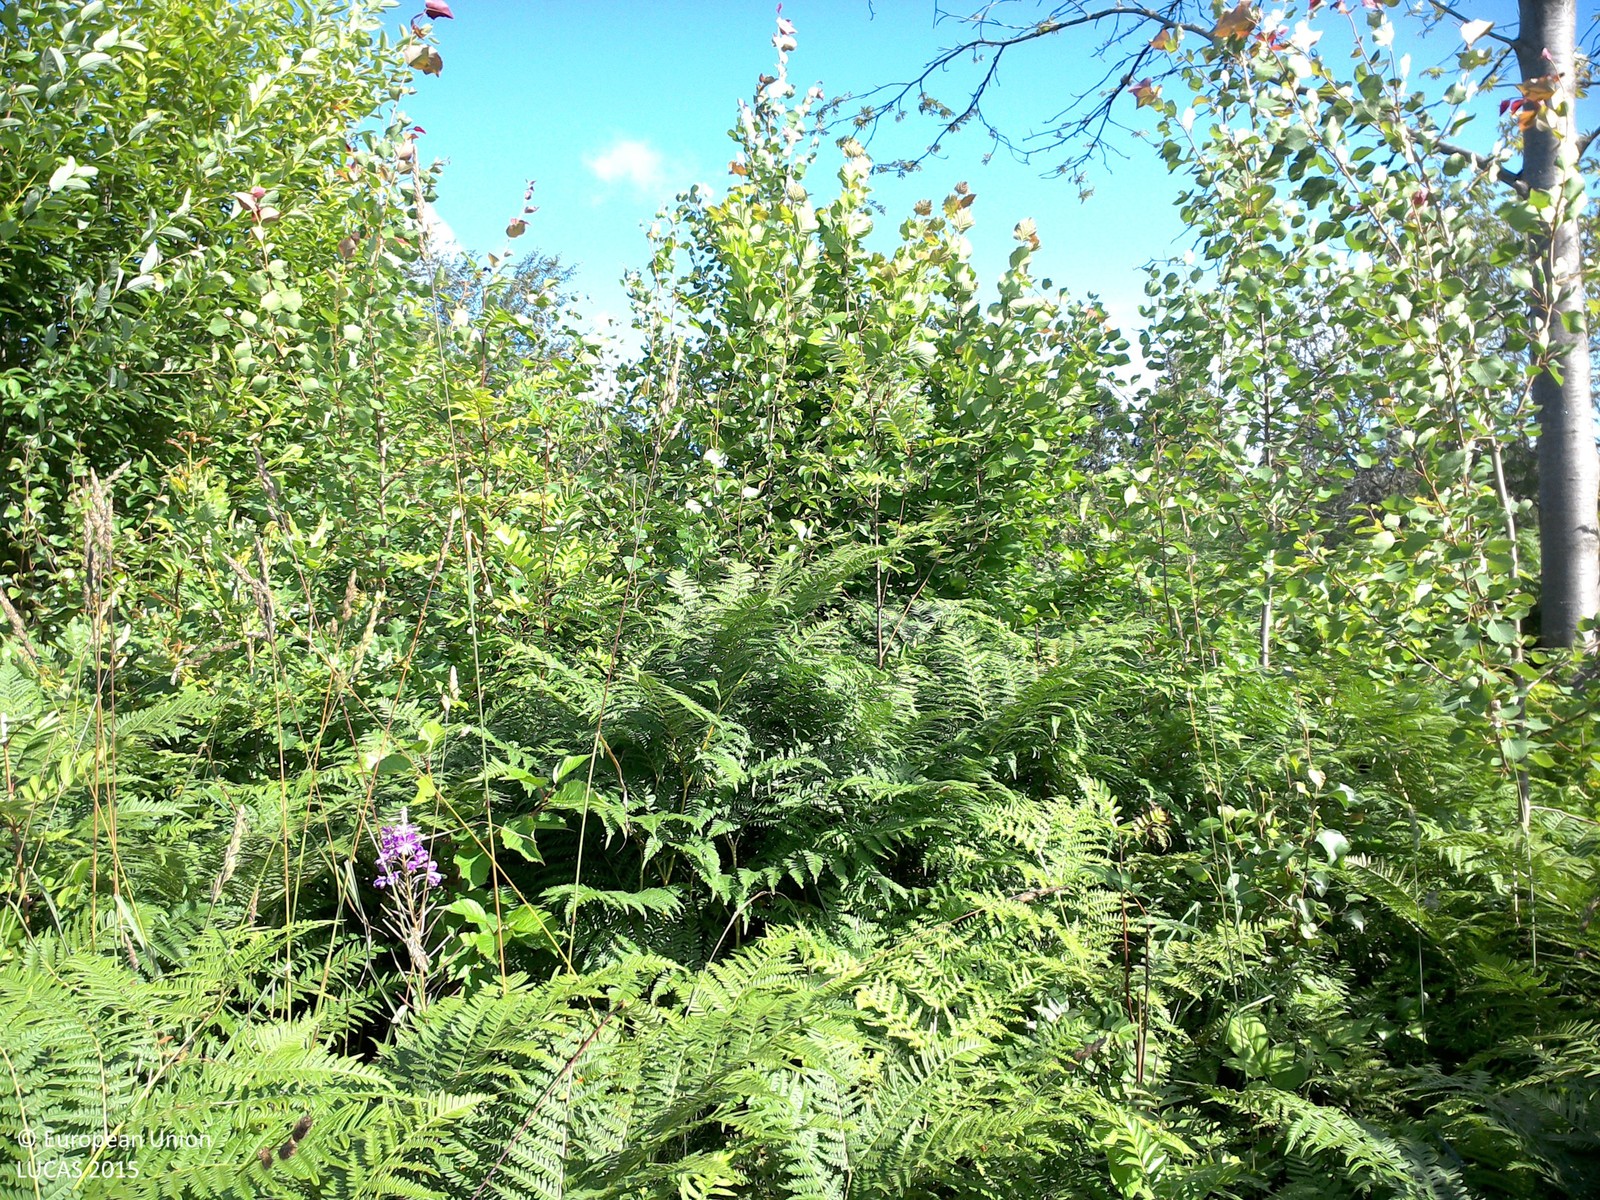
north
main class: Woodland
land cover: Broadleaved woodland
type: boreal forest
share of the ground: > 75 %
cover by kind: broadleaved forest trees 75 %, herbaceous plants 25 %
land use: Forestry
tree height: < 5 m
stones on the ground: < 10 %
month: July
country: SE
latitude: 57.9533
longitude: 14.8106
